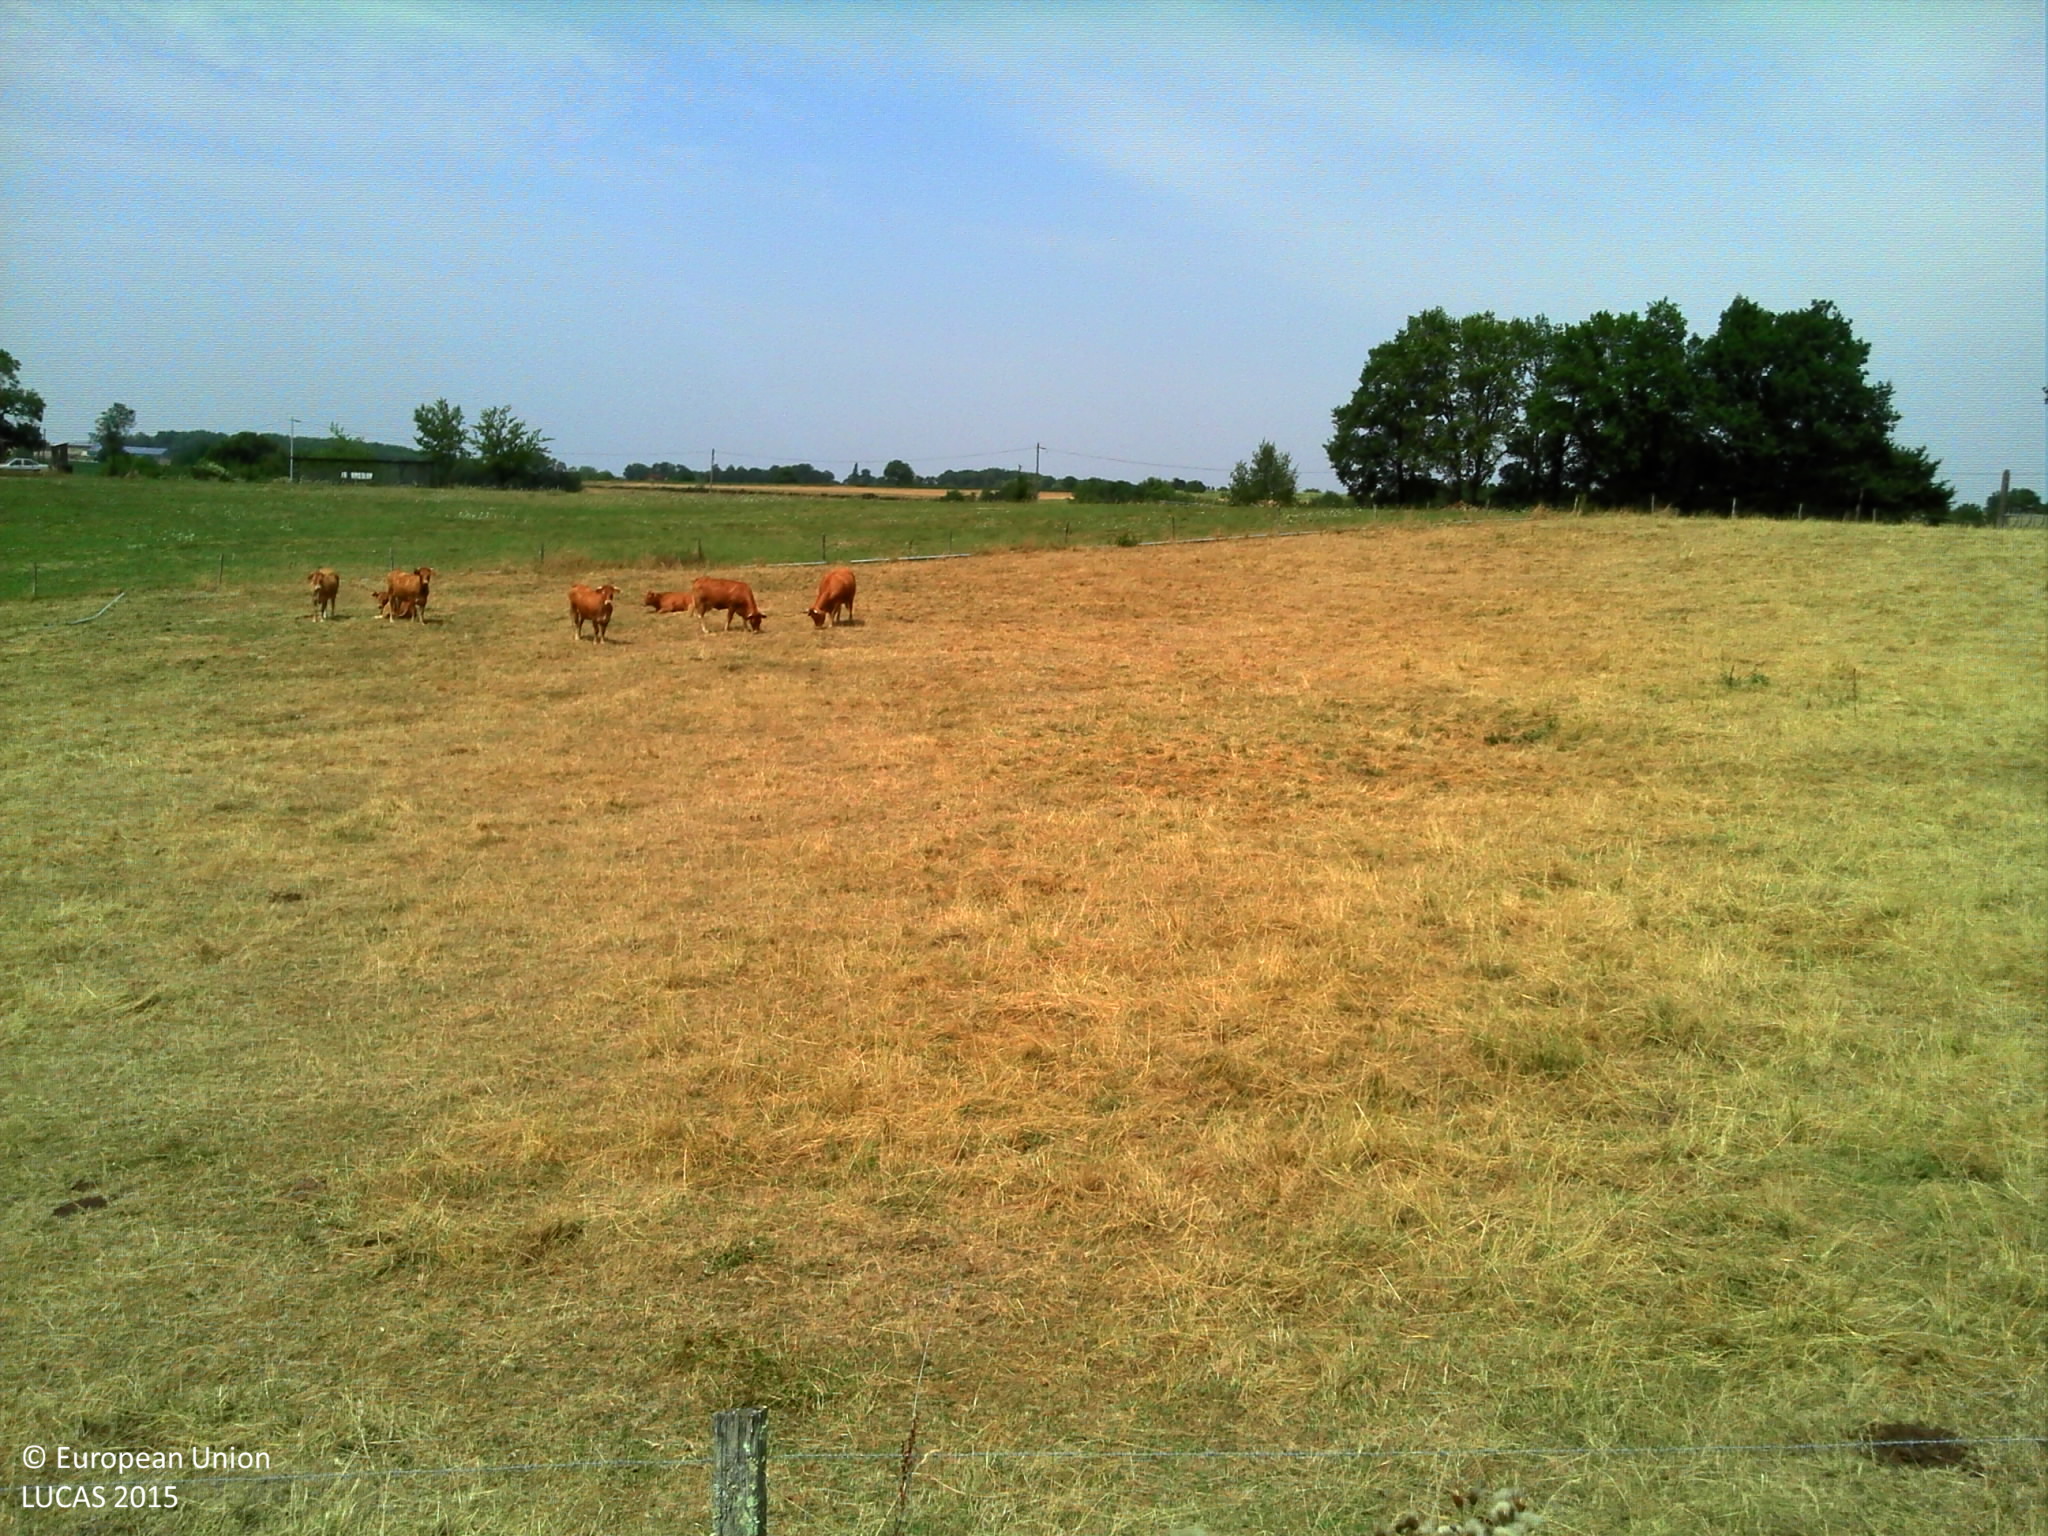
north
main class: Grassland
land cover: Spontaneously vegetated surfaces
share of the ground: > 75 %
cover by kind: herbaceous plants 100 %
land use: Semi-natural and natural areas not in use
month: July
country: FR
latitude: 45.2021
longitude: 1.1194
